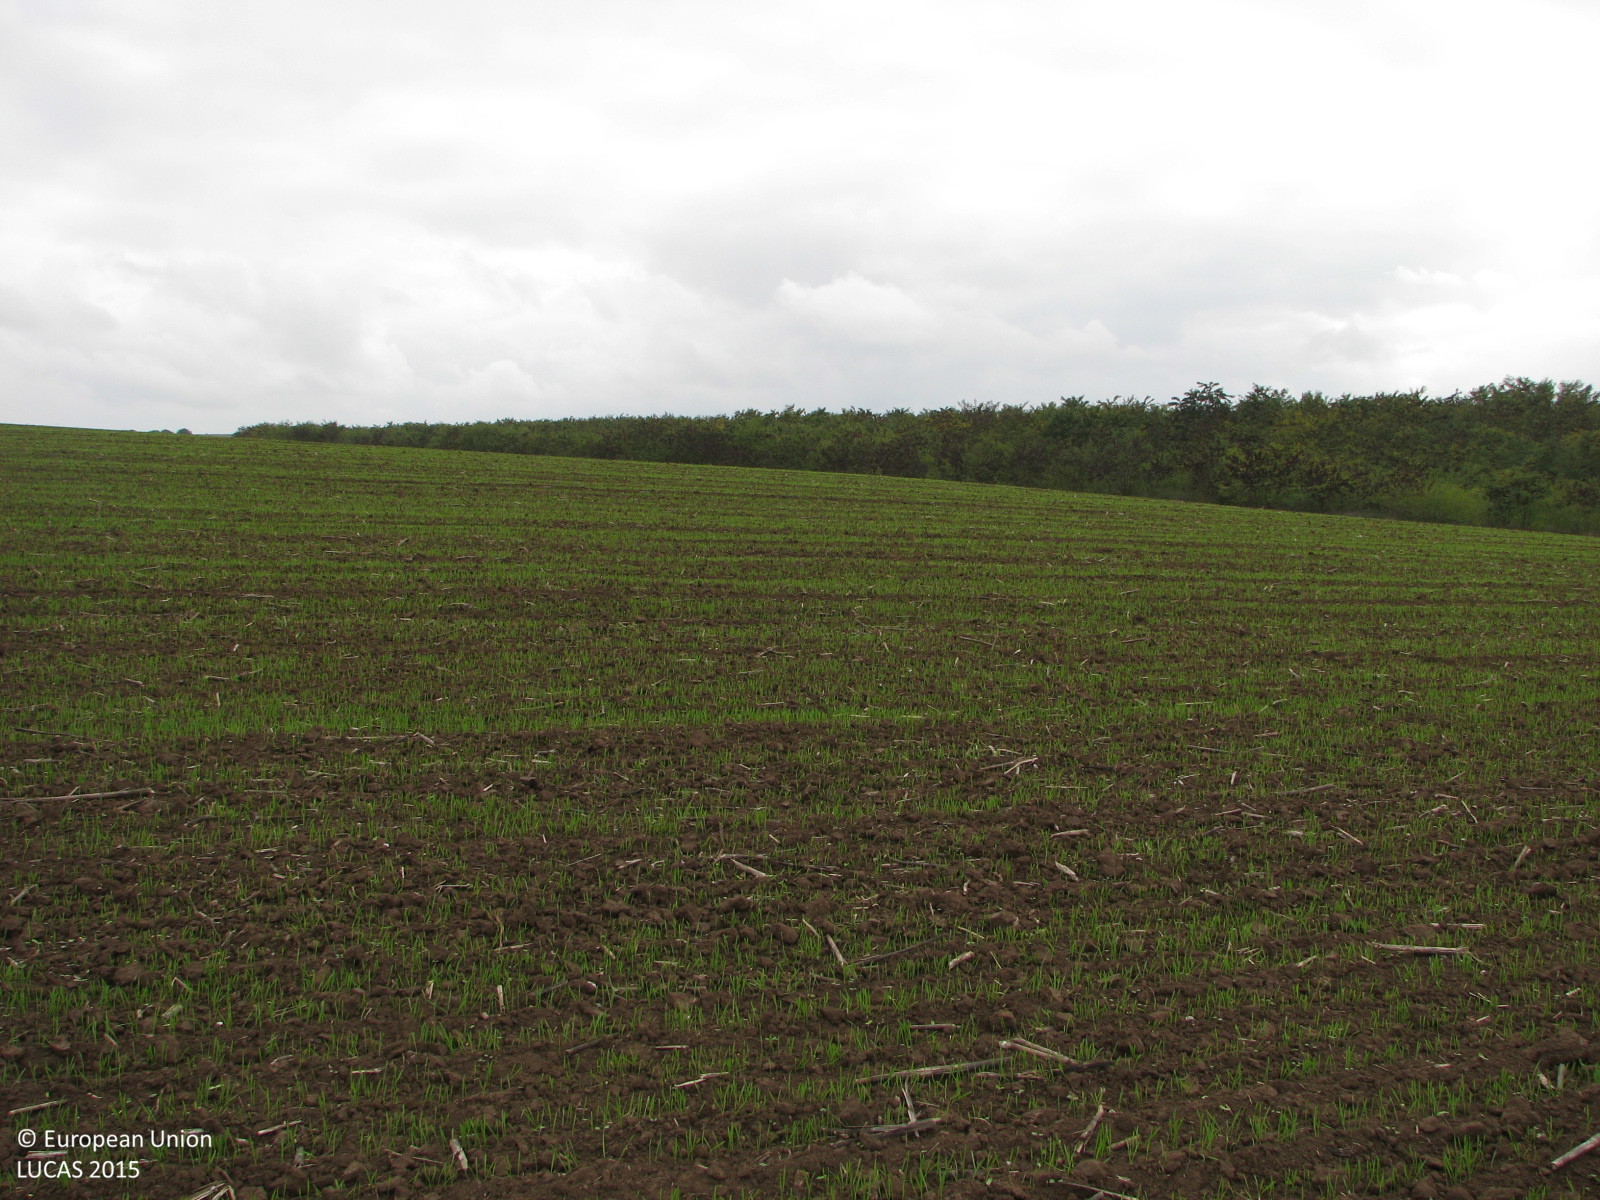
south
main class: Cropland
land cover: Common wheat
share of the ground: > 75 %
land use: Agriculture (excluding fallow land and kitchen gardens)
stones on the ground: < 10 %
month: October
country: BG
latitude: 42.5630
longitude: 26.2511
